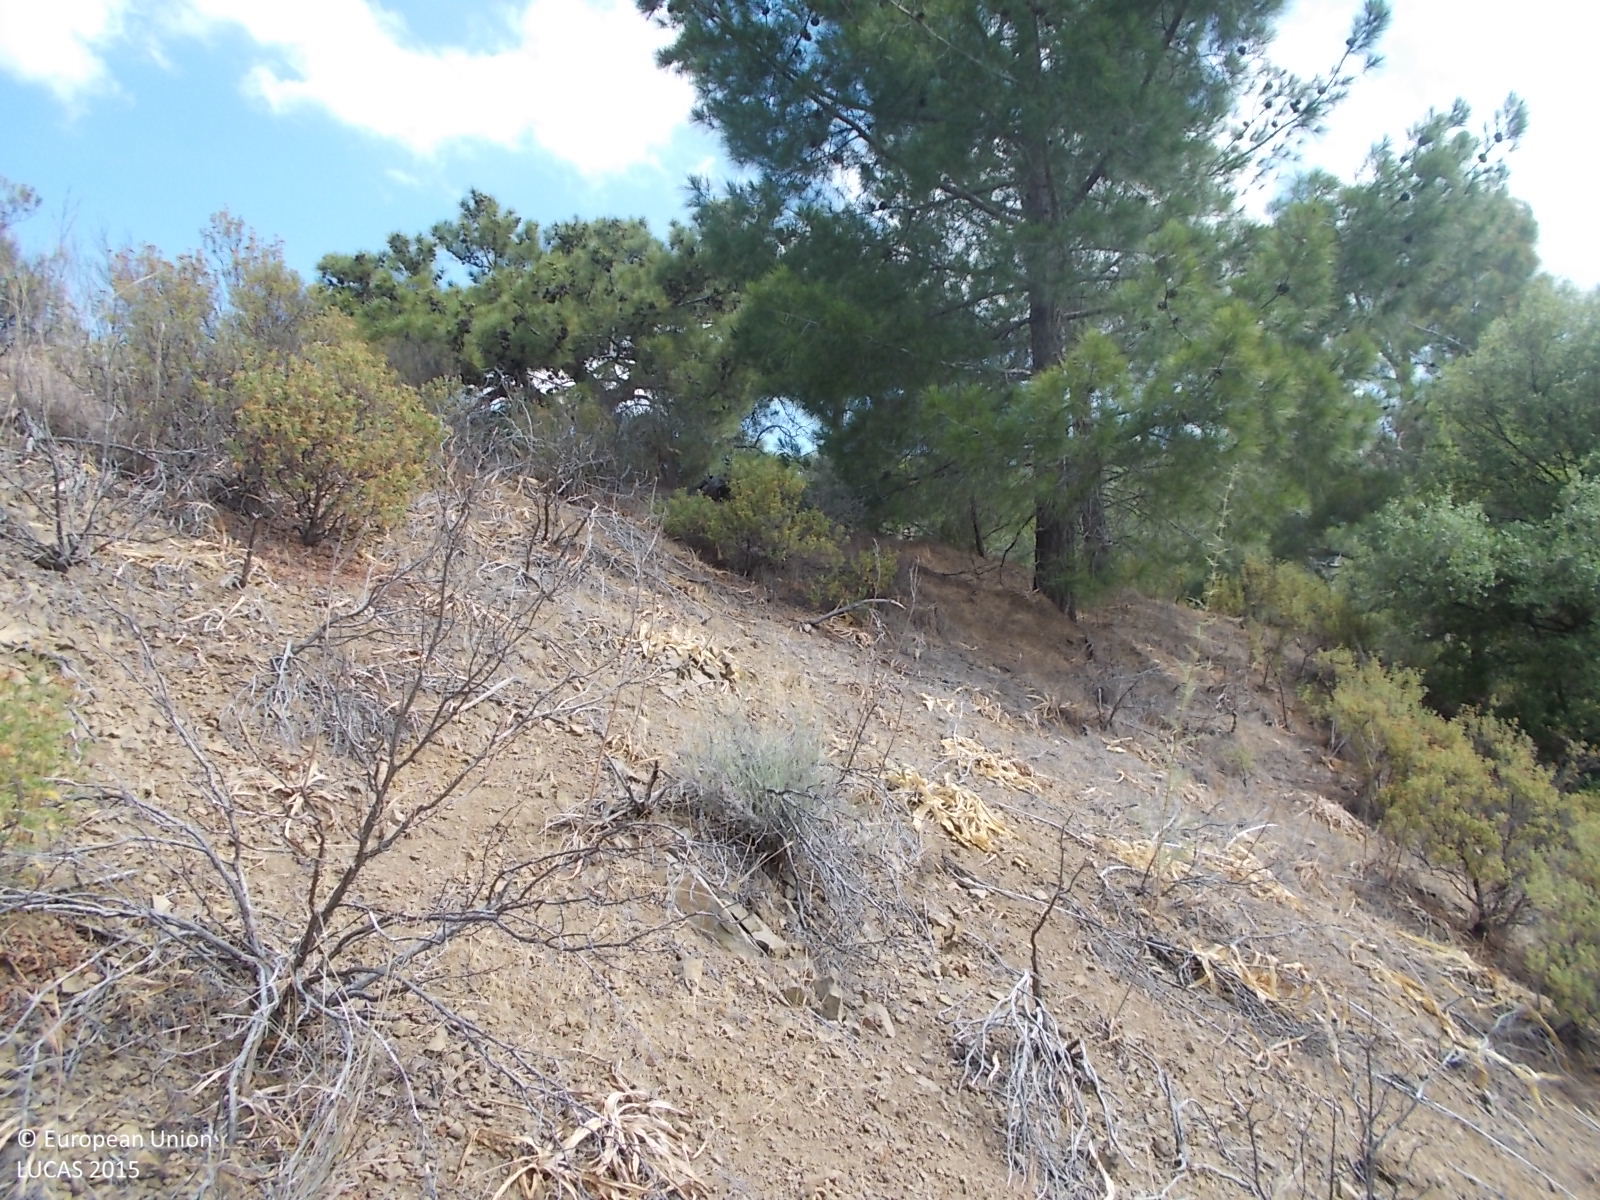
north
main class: Woodland
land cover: Pine dominated coniferous woodland
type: coniferous forest of the mediterranean region
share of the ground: 25 - 50 %
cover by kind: shrubs 35 %, unconsolidated bare surface 35 %, coniferous forest trees 30 %
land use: Forestry
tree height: > 5 m
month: June
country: CY
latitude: 34.9052
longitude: 32.7839
